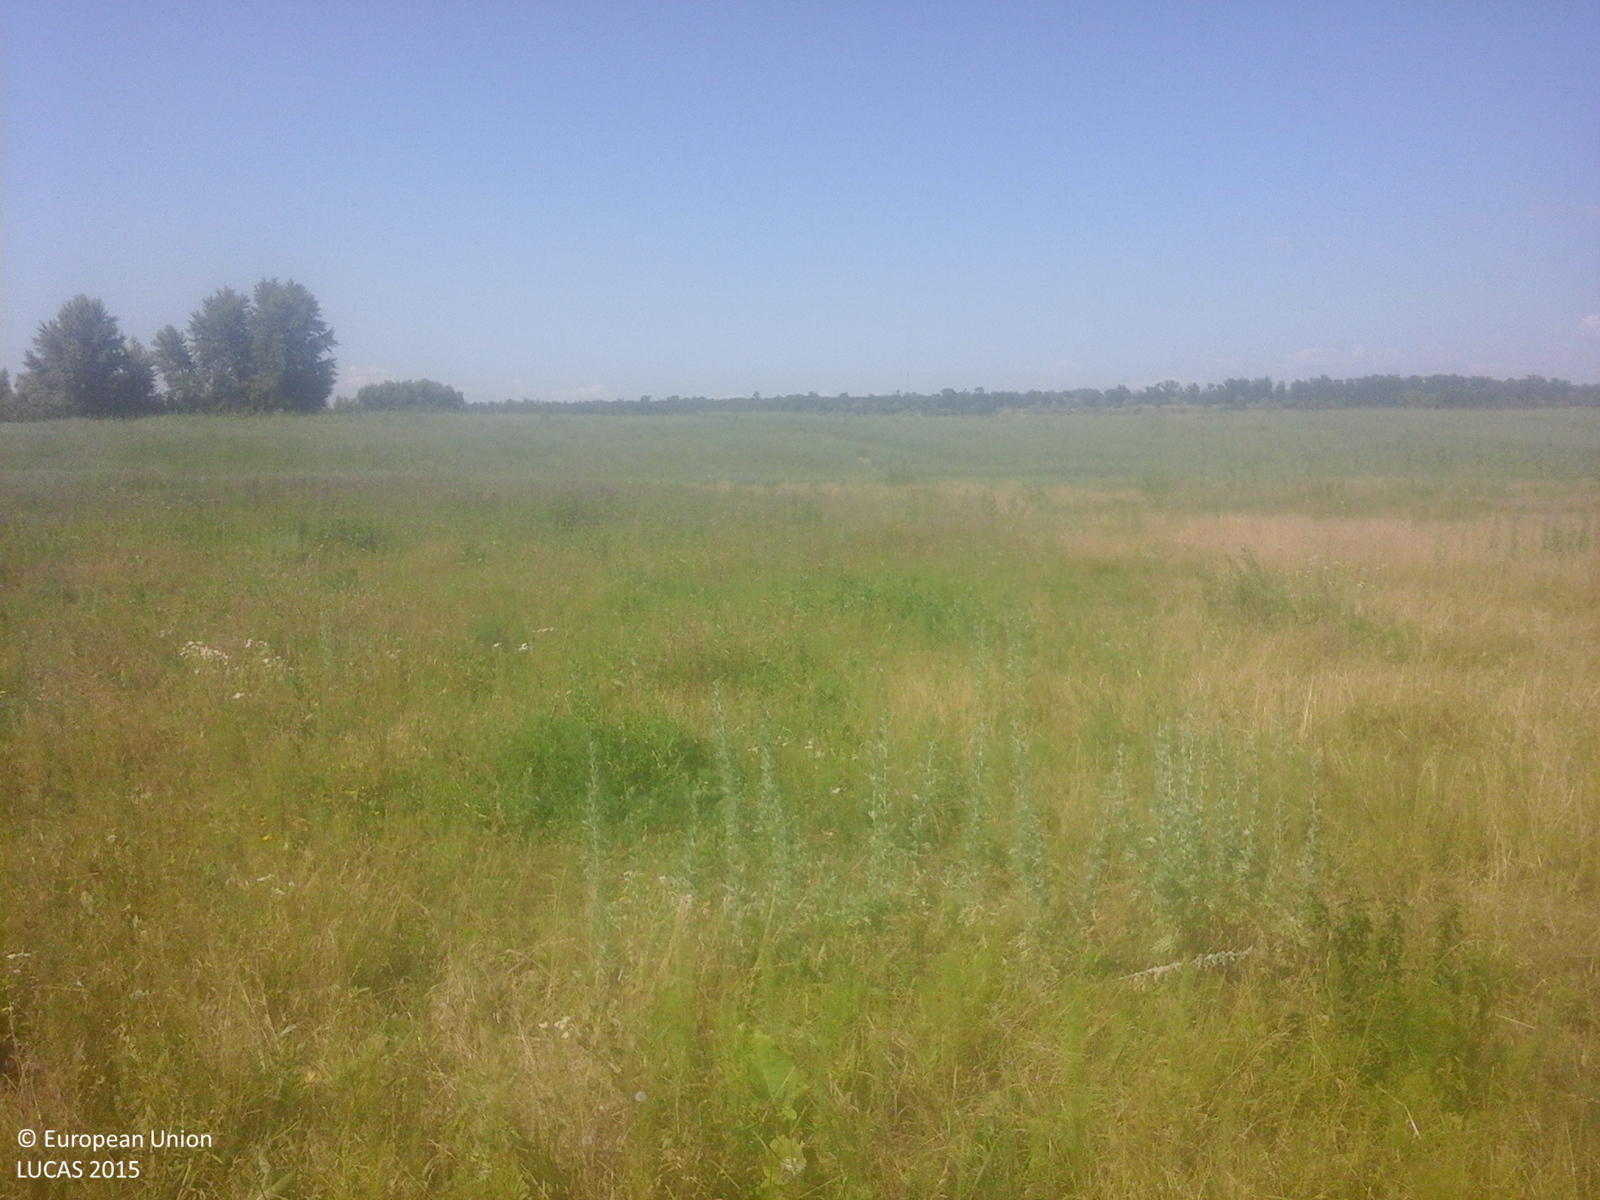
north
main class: Grassland
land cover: Grassland without tree/shrub cover
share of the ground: > 75 %
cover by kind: herbaceous plants 100 %
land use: Agriculture (excluding fallow land and kitchen gardens)
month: June
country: RO
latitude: 47.2878
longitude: 27.7224
